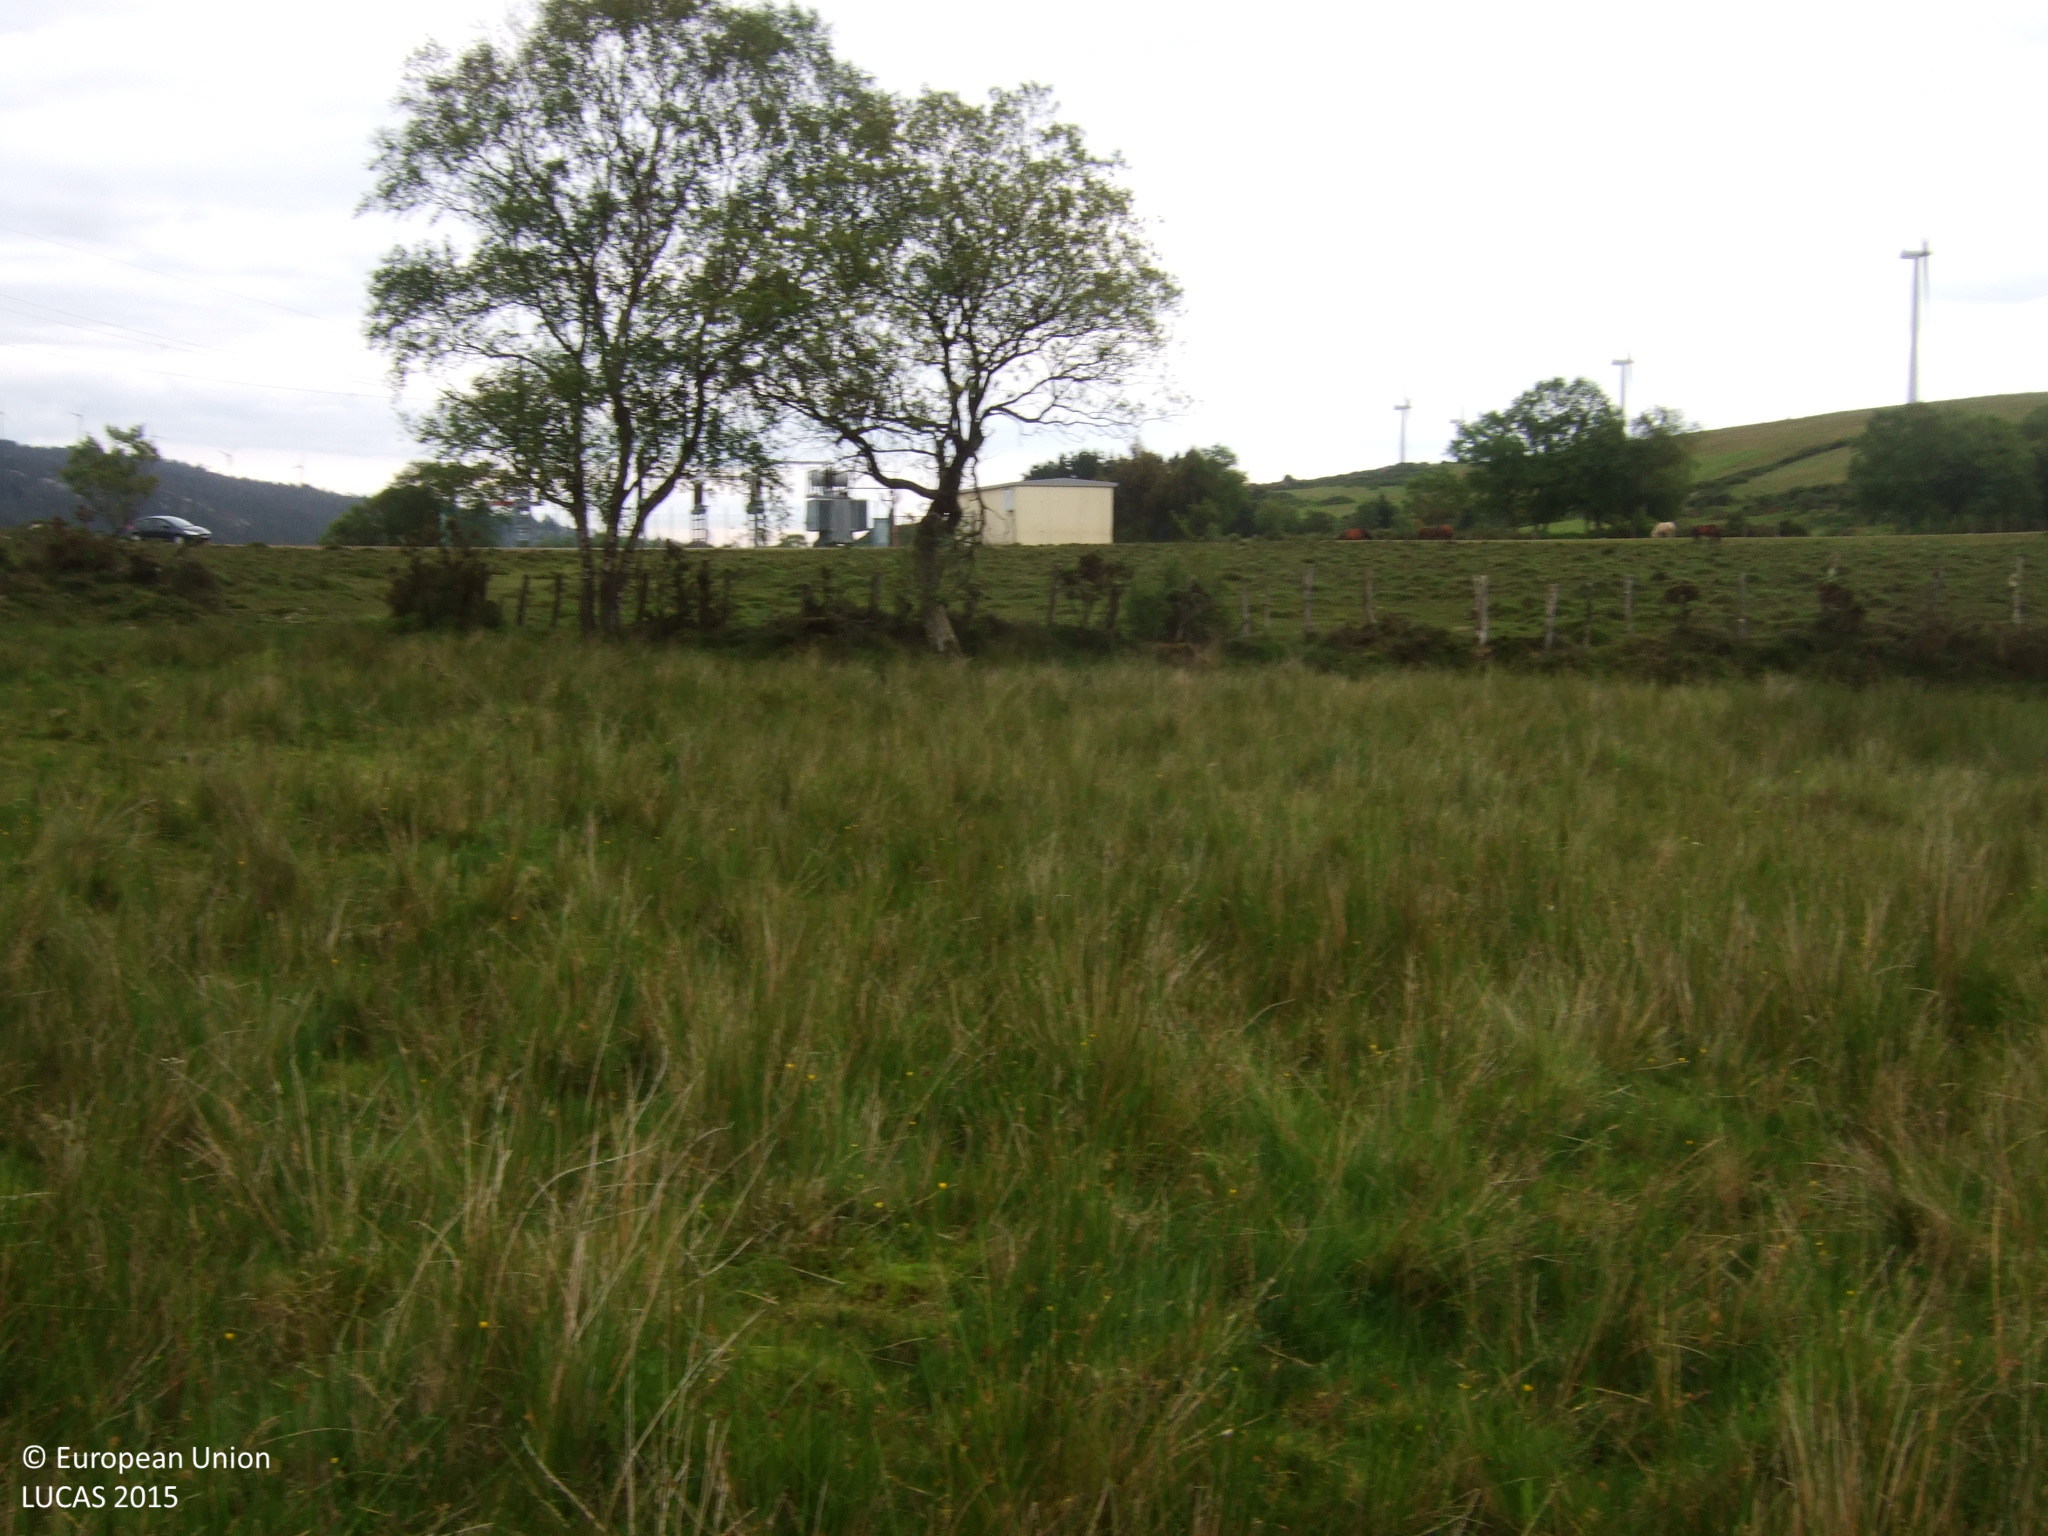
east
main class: Grassland
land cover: Grassland without tree/shrub cover
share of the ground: > 75 %
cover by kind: herbaceous plants 100 %
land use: Agriculture (excluding fallow land and kitchen gardens)
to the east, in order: Grassland without tree/shrub cover; Fences; Shrubland without tree cover; Artificial constructions in urban areas; Grassland without tree/shrub cover; Fences; Grassland without tree/shrub cover
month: June
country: ES
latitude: 43.4231
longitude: -7.4839
